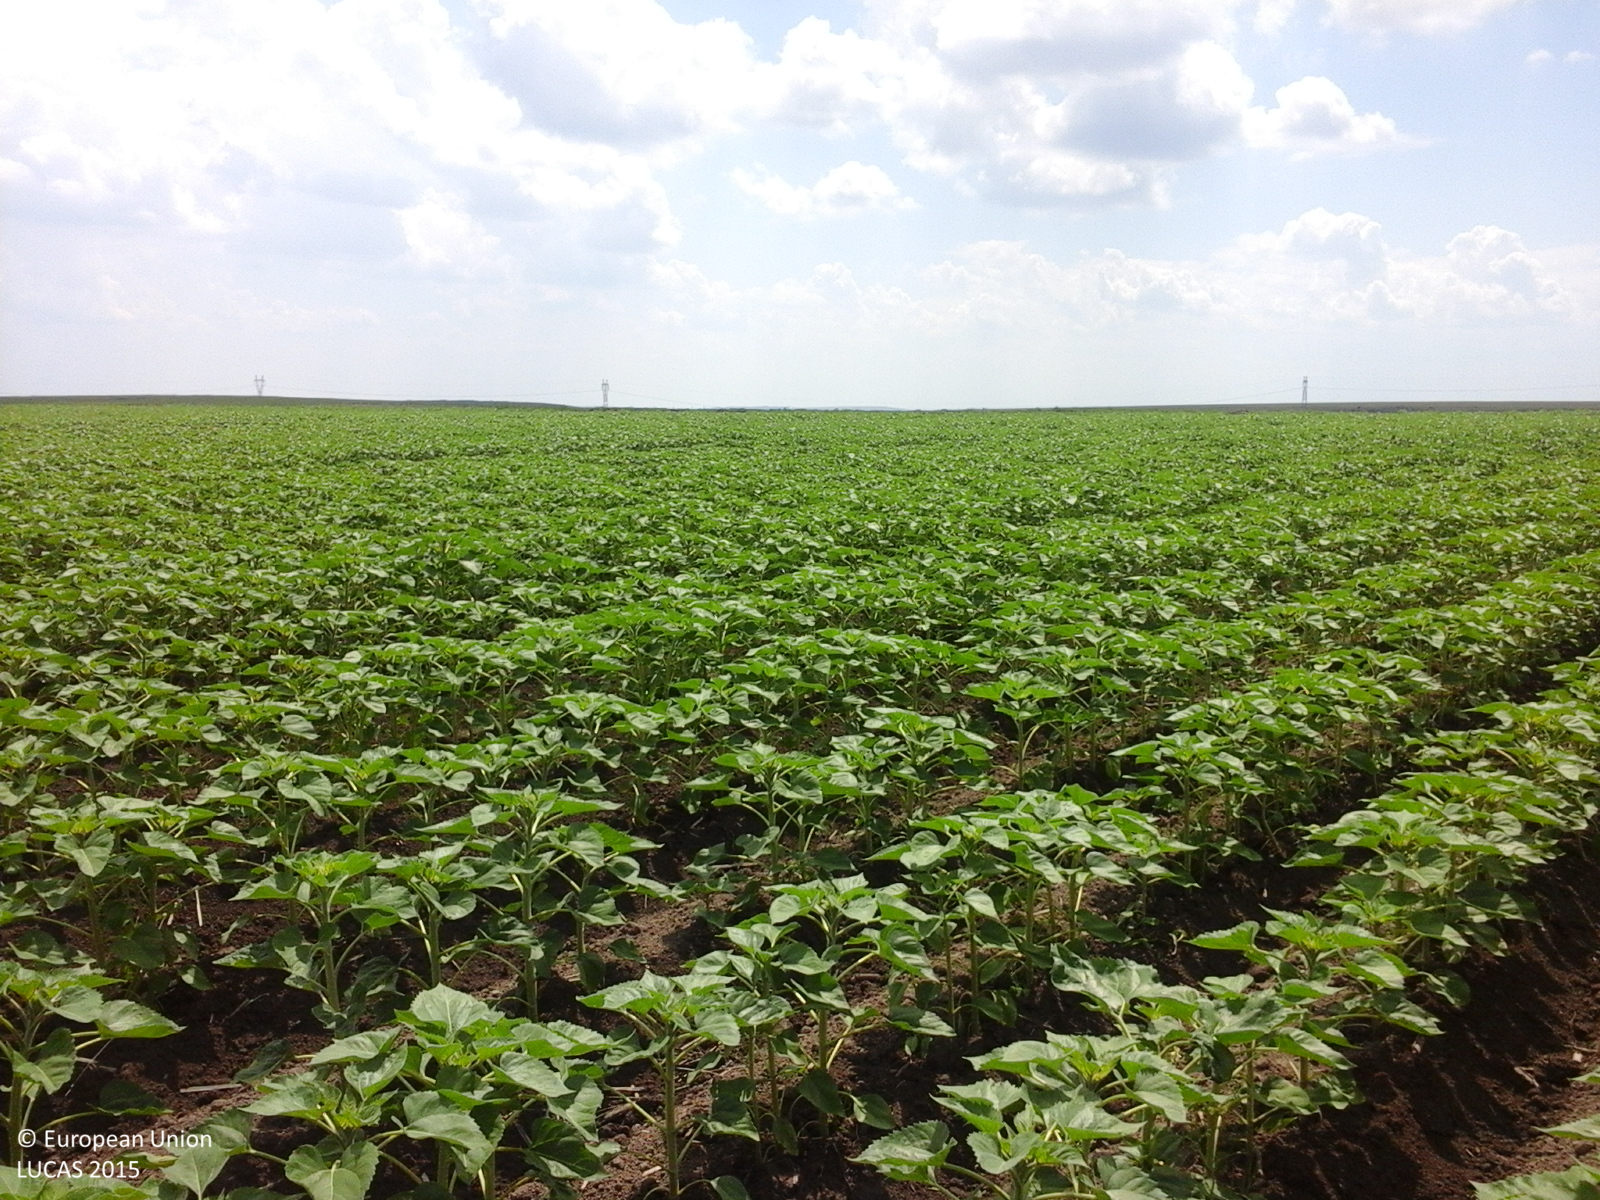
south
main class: Cropland
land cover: Sunflower
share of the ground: 50 - 75 %
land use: Agriculture (excluding fallow land and kitchen gardens)
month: June
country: RO
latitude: 47.3128
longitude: 26.8853
